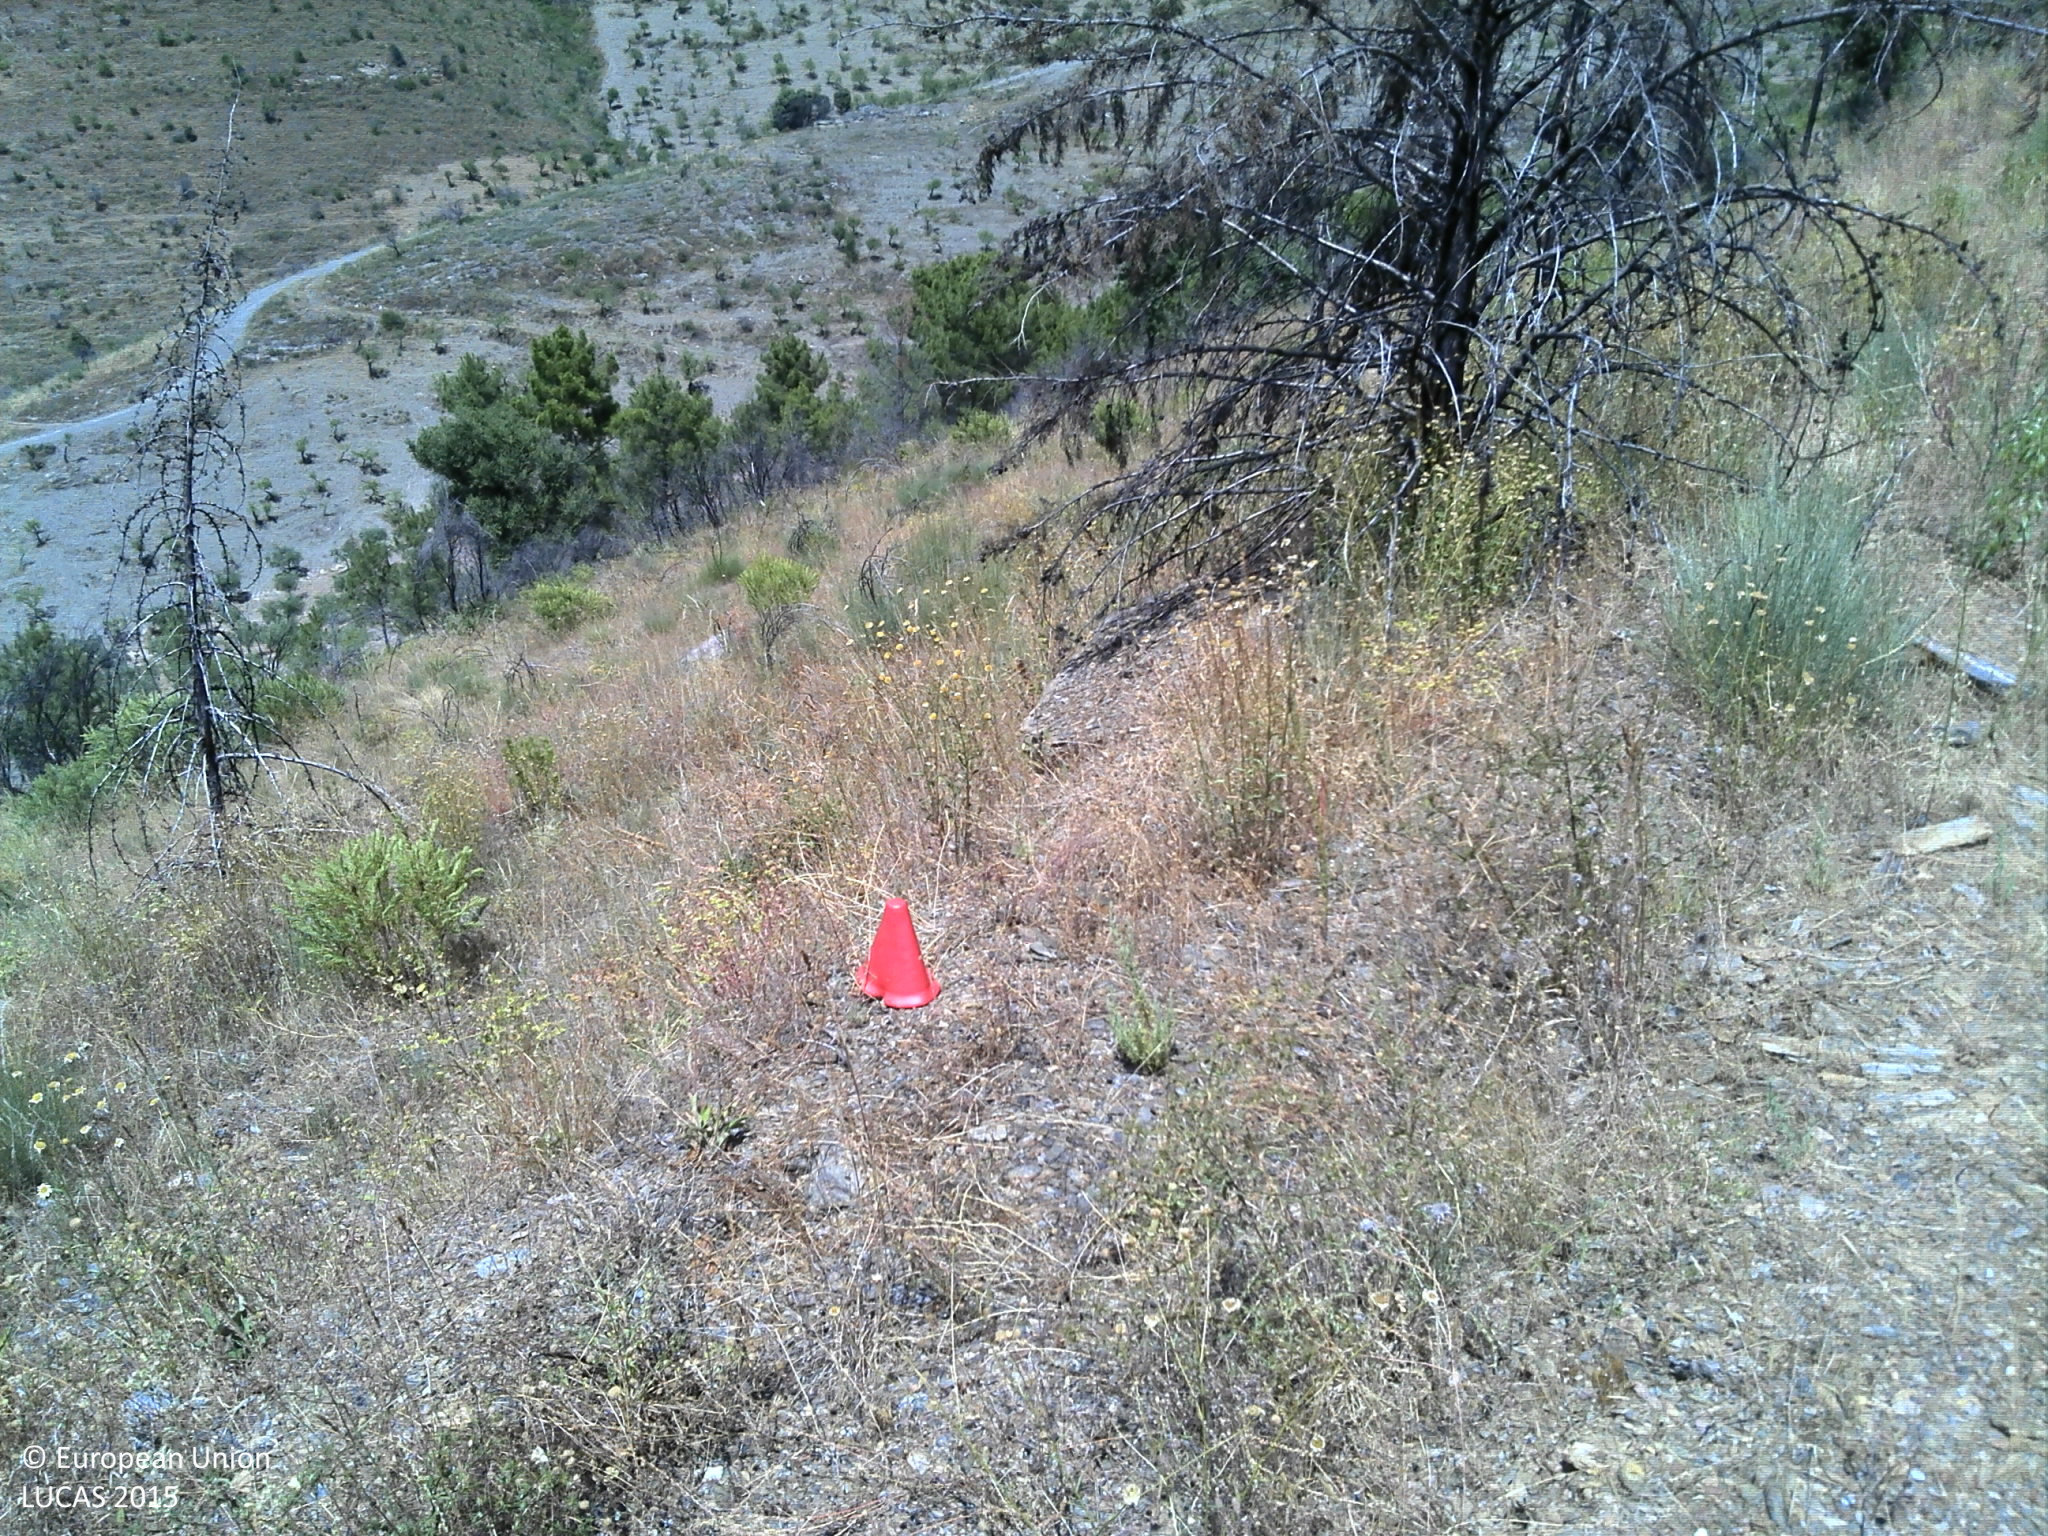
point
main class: Shrubland
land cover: Shrubland without tree cover
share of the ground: 25 - 50 %
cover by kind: herbaceous plants 50 %, unconsolidated bare surface 20 %, shrubs 10 %
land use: Abandoned areas
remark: Burnt area
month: June
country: PT
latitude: 41.2353
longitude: -6.8216
